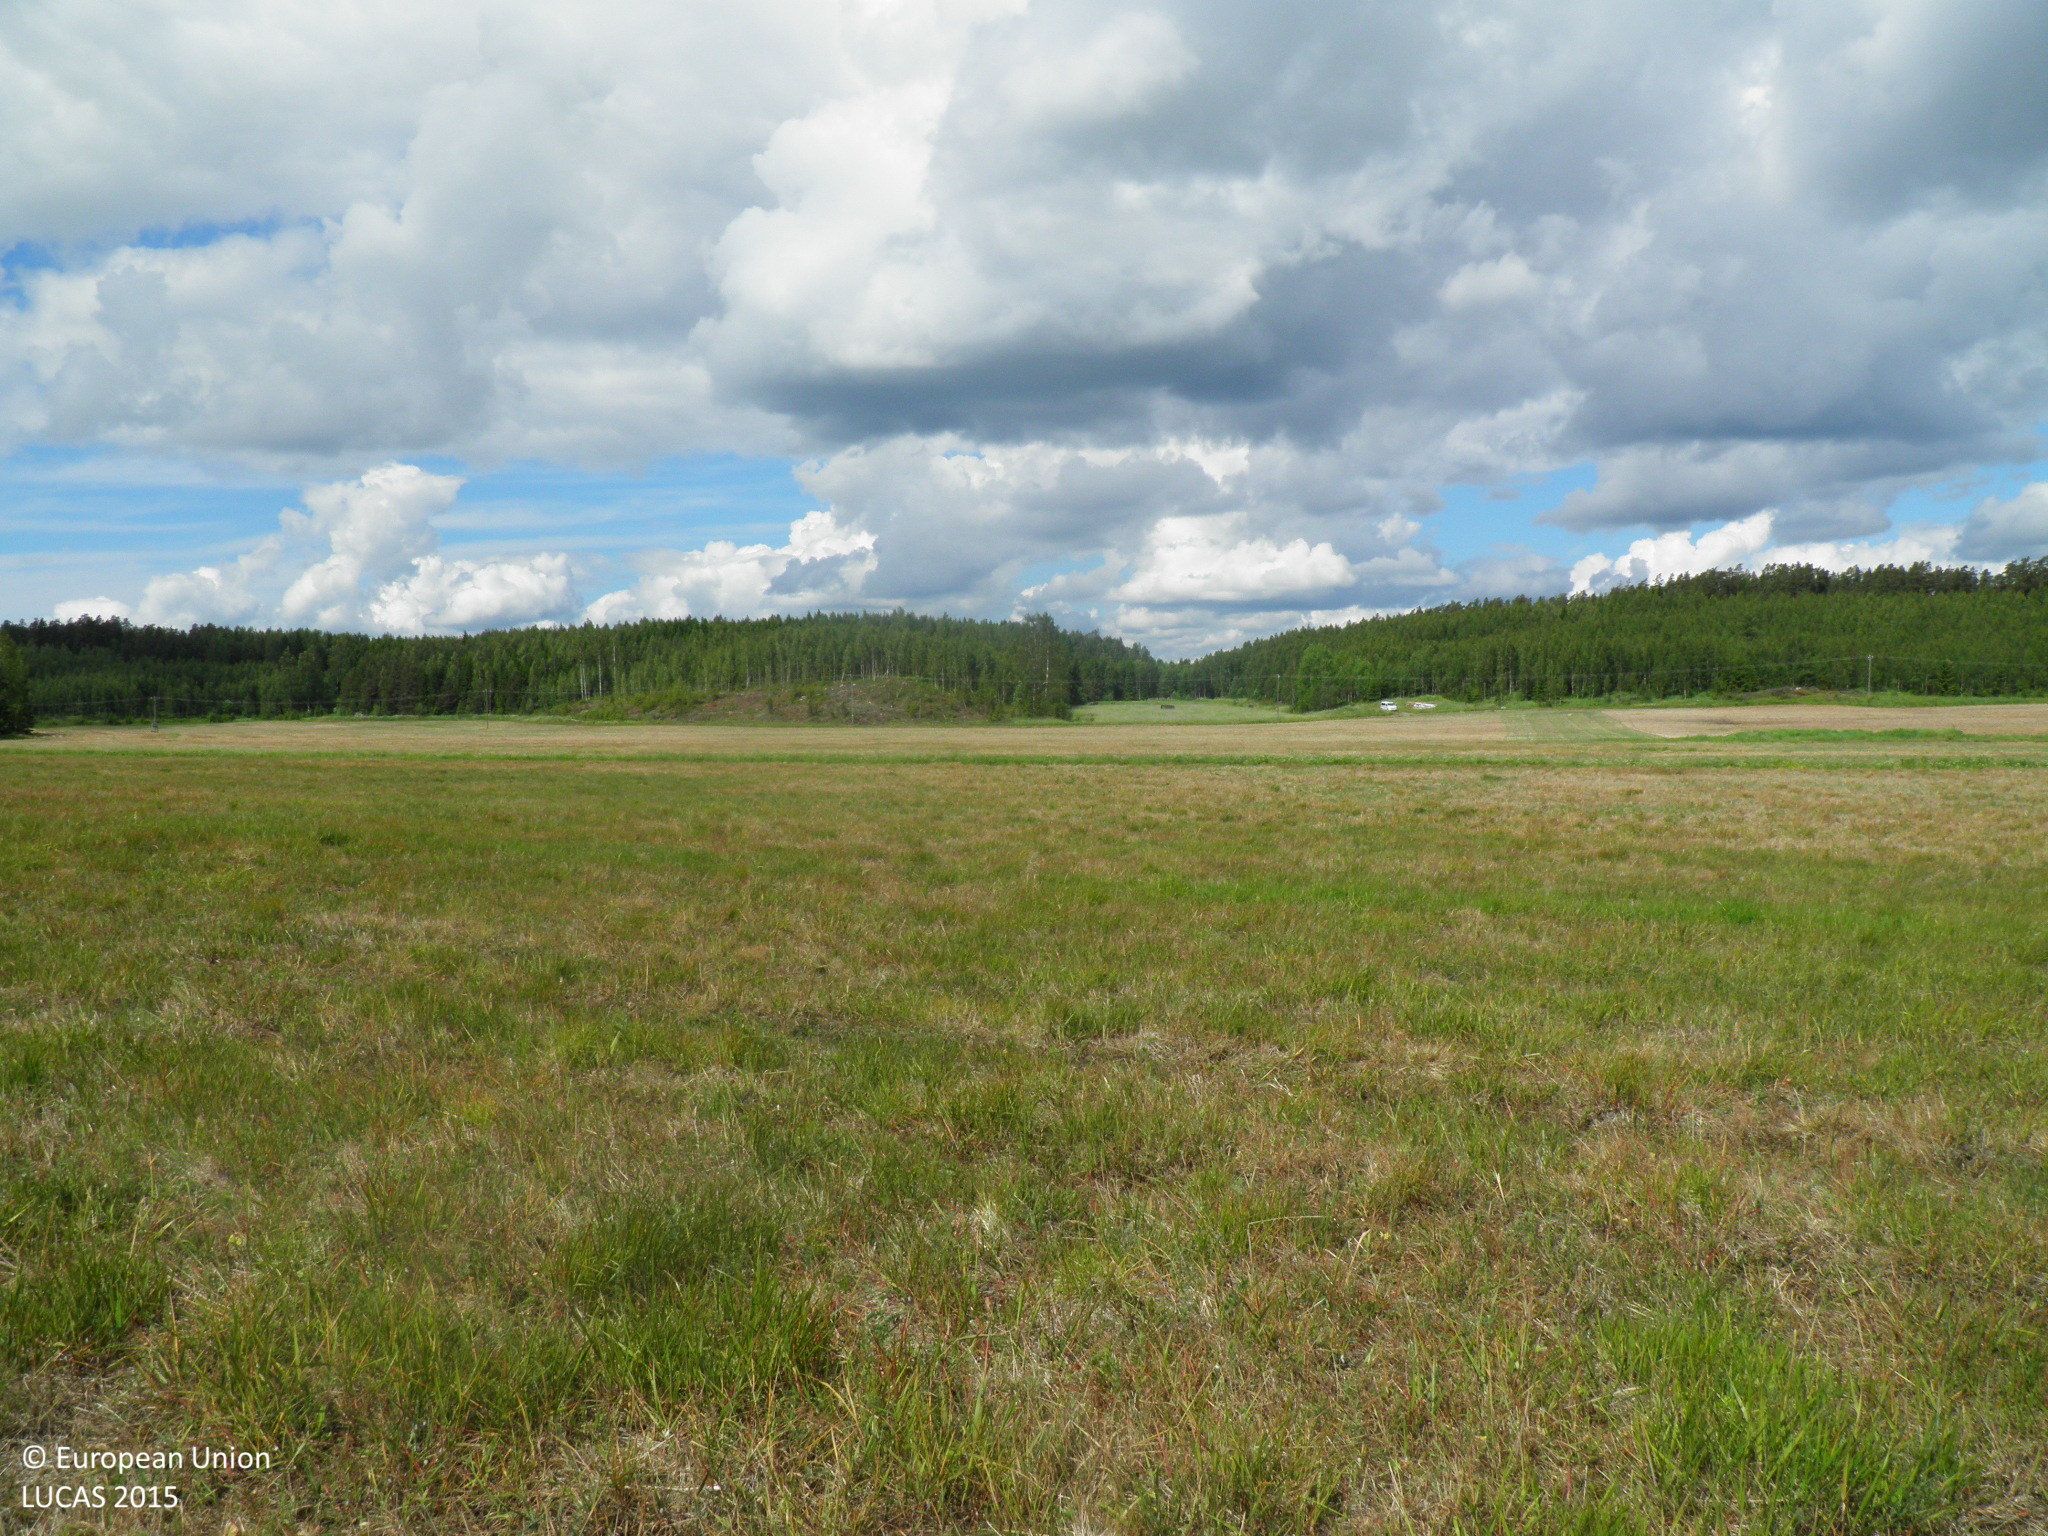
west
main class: Grassland
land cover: Spontaneously vegetated surfaces
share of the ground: > 75 %
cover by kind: herbaceous plants 90 %, unconsolidated bare surface 10 %
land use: Fallow land
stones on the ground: < 10 %
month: June
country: FI
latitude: 60.2943
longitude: 22.5368
